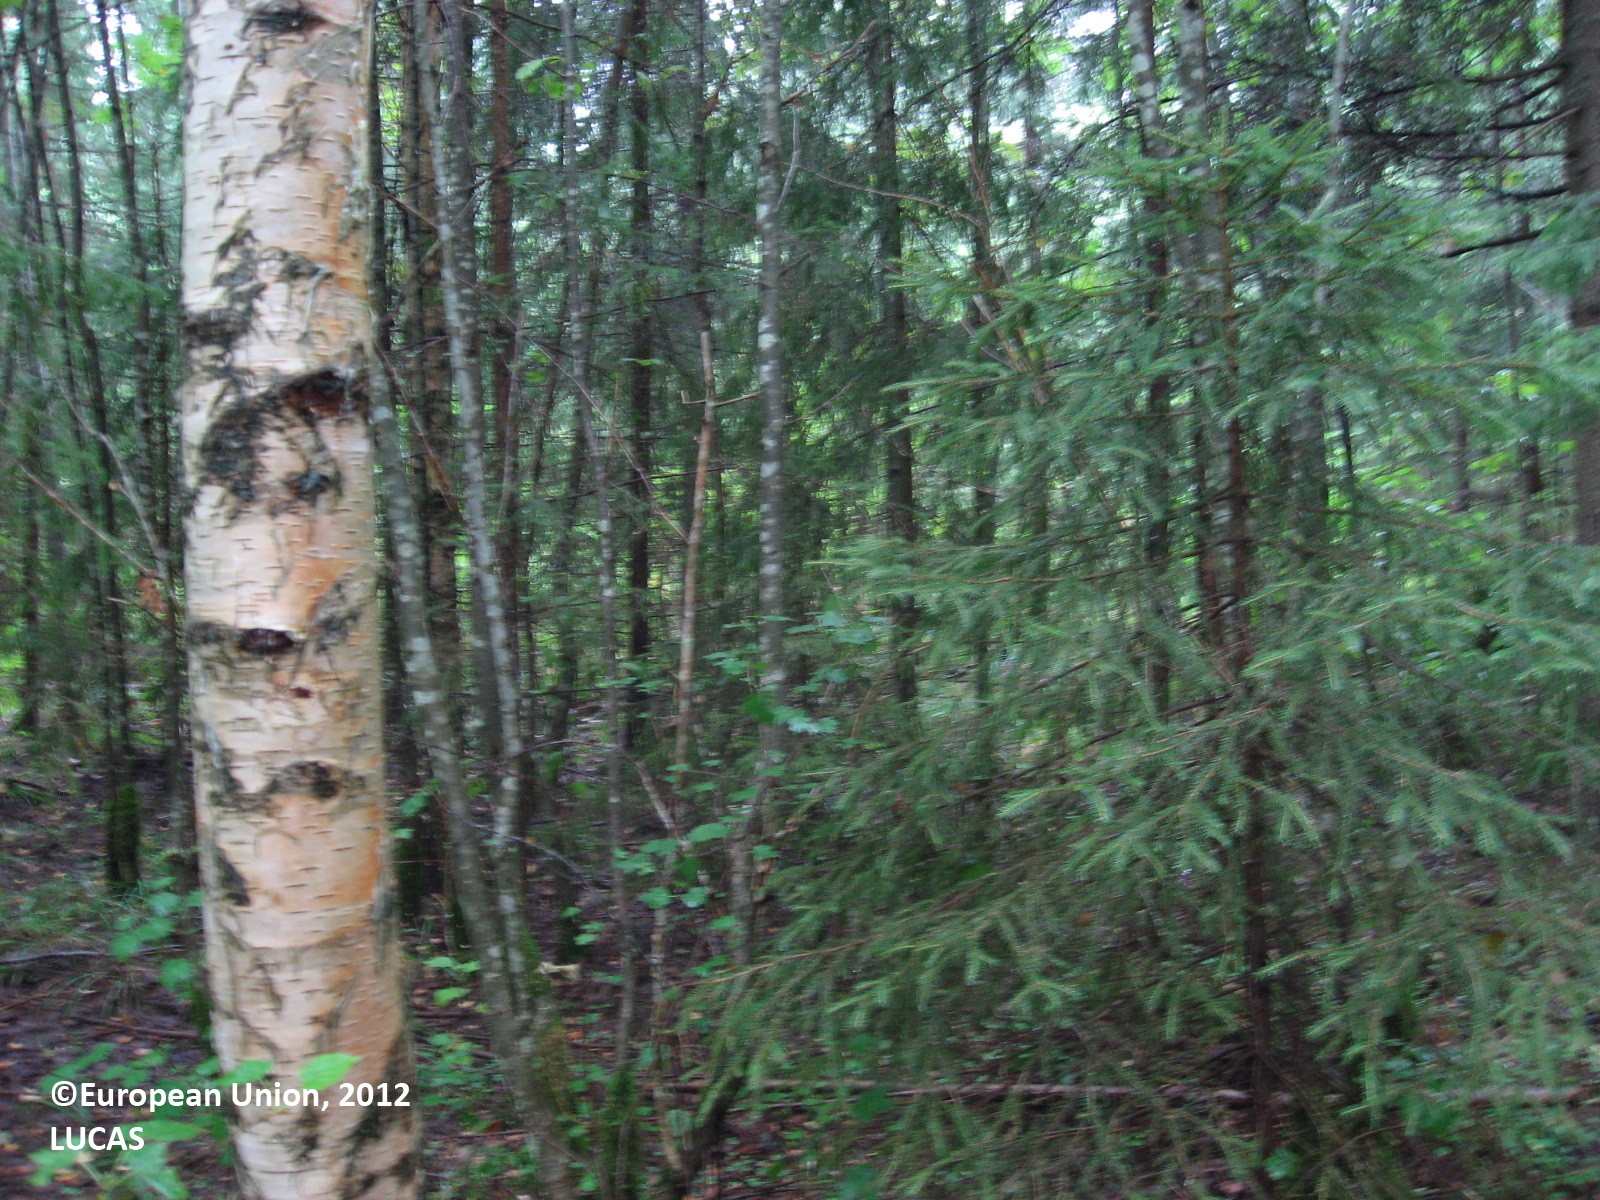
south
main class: Woodland
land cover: Spruce dominated mixed woodland
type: boreal forest
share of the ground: > 75 %
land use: Forestry
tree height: > 5 m
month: August
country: FI
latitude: 61.0441
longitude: 24.8300
